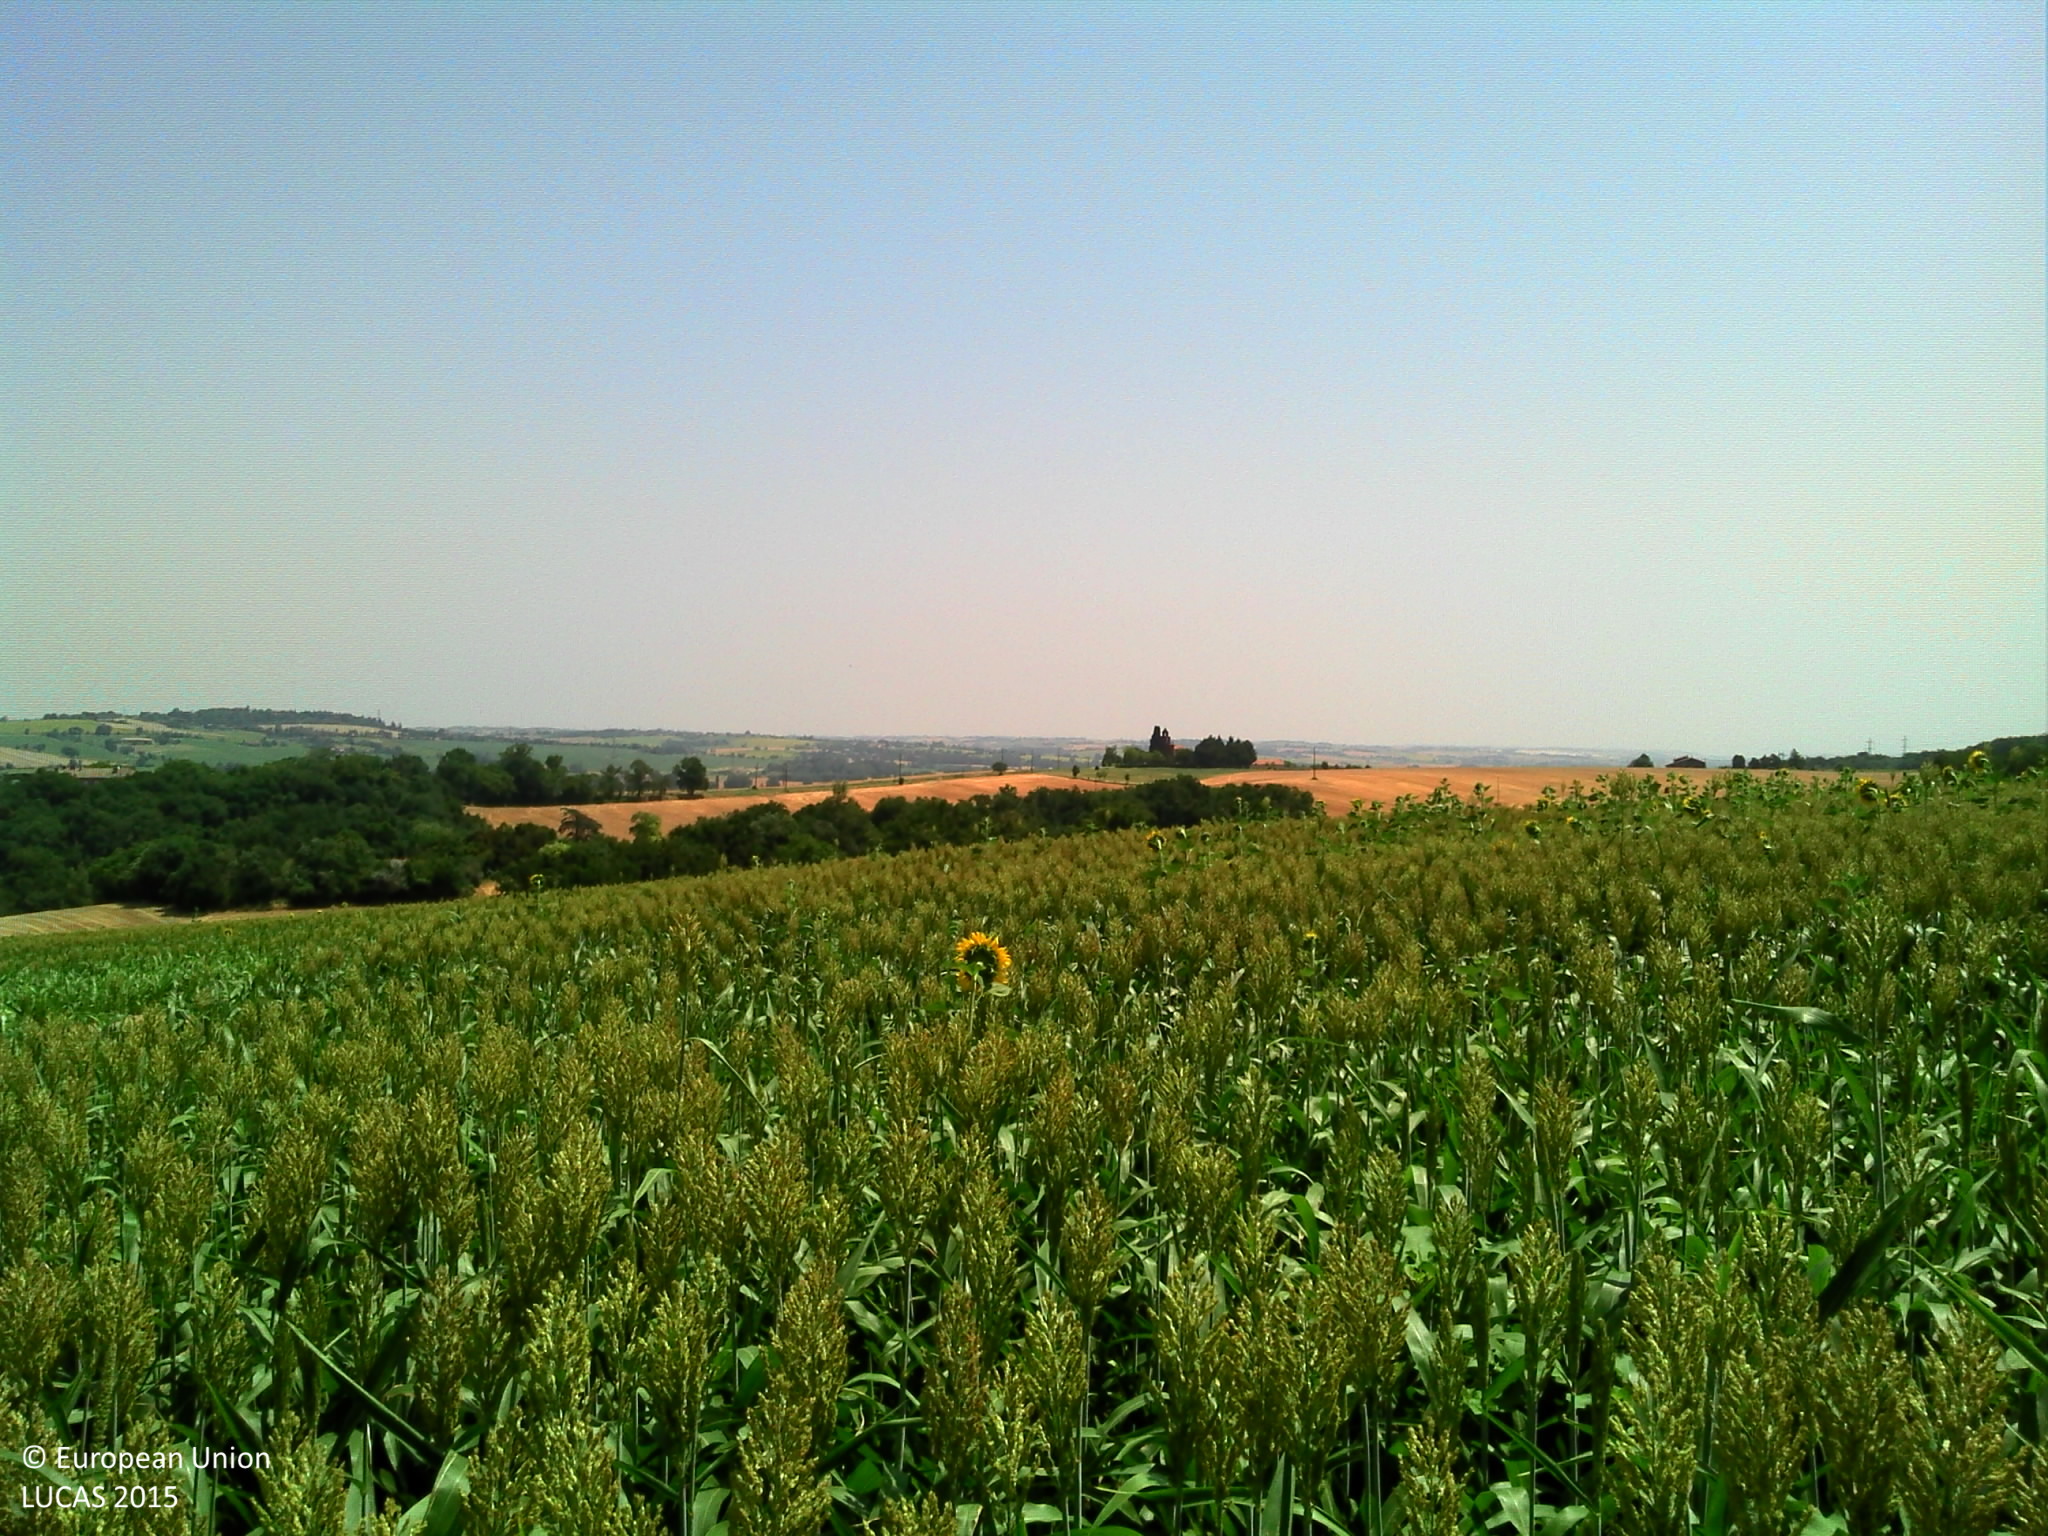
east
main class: Grassland
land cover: Grassland without tree/shrub cover
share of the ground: > 75 %
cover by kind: herbaceous plants 100 %
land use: Agriculture (excluding fallow land and kitchen gardens)
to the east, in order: Grassland without tree/shrub cover; Fences; Grass margins; Other cereals; Grass margins; Other cereals
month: July
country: FR
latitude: 43.6318
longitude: 1.6370
